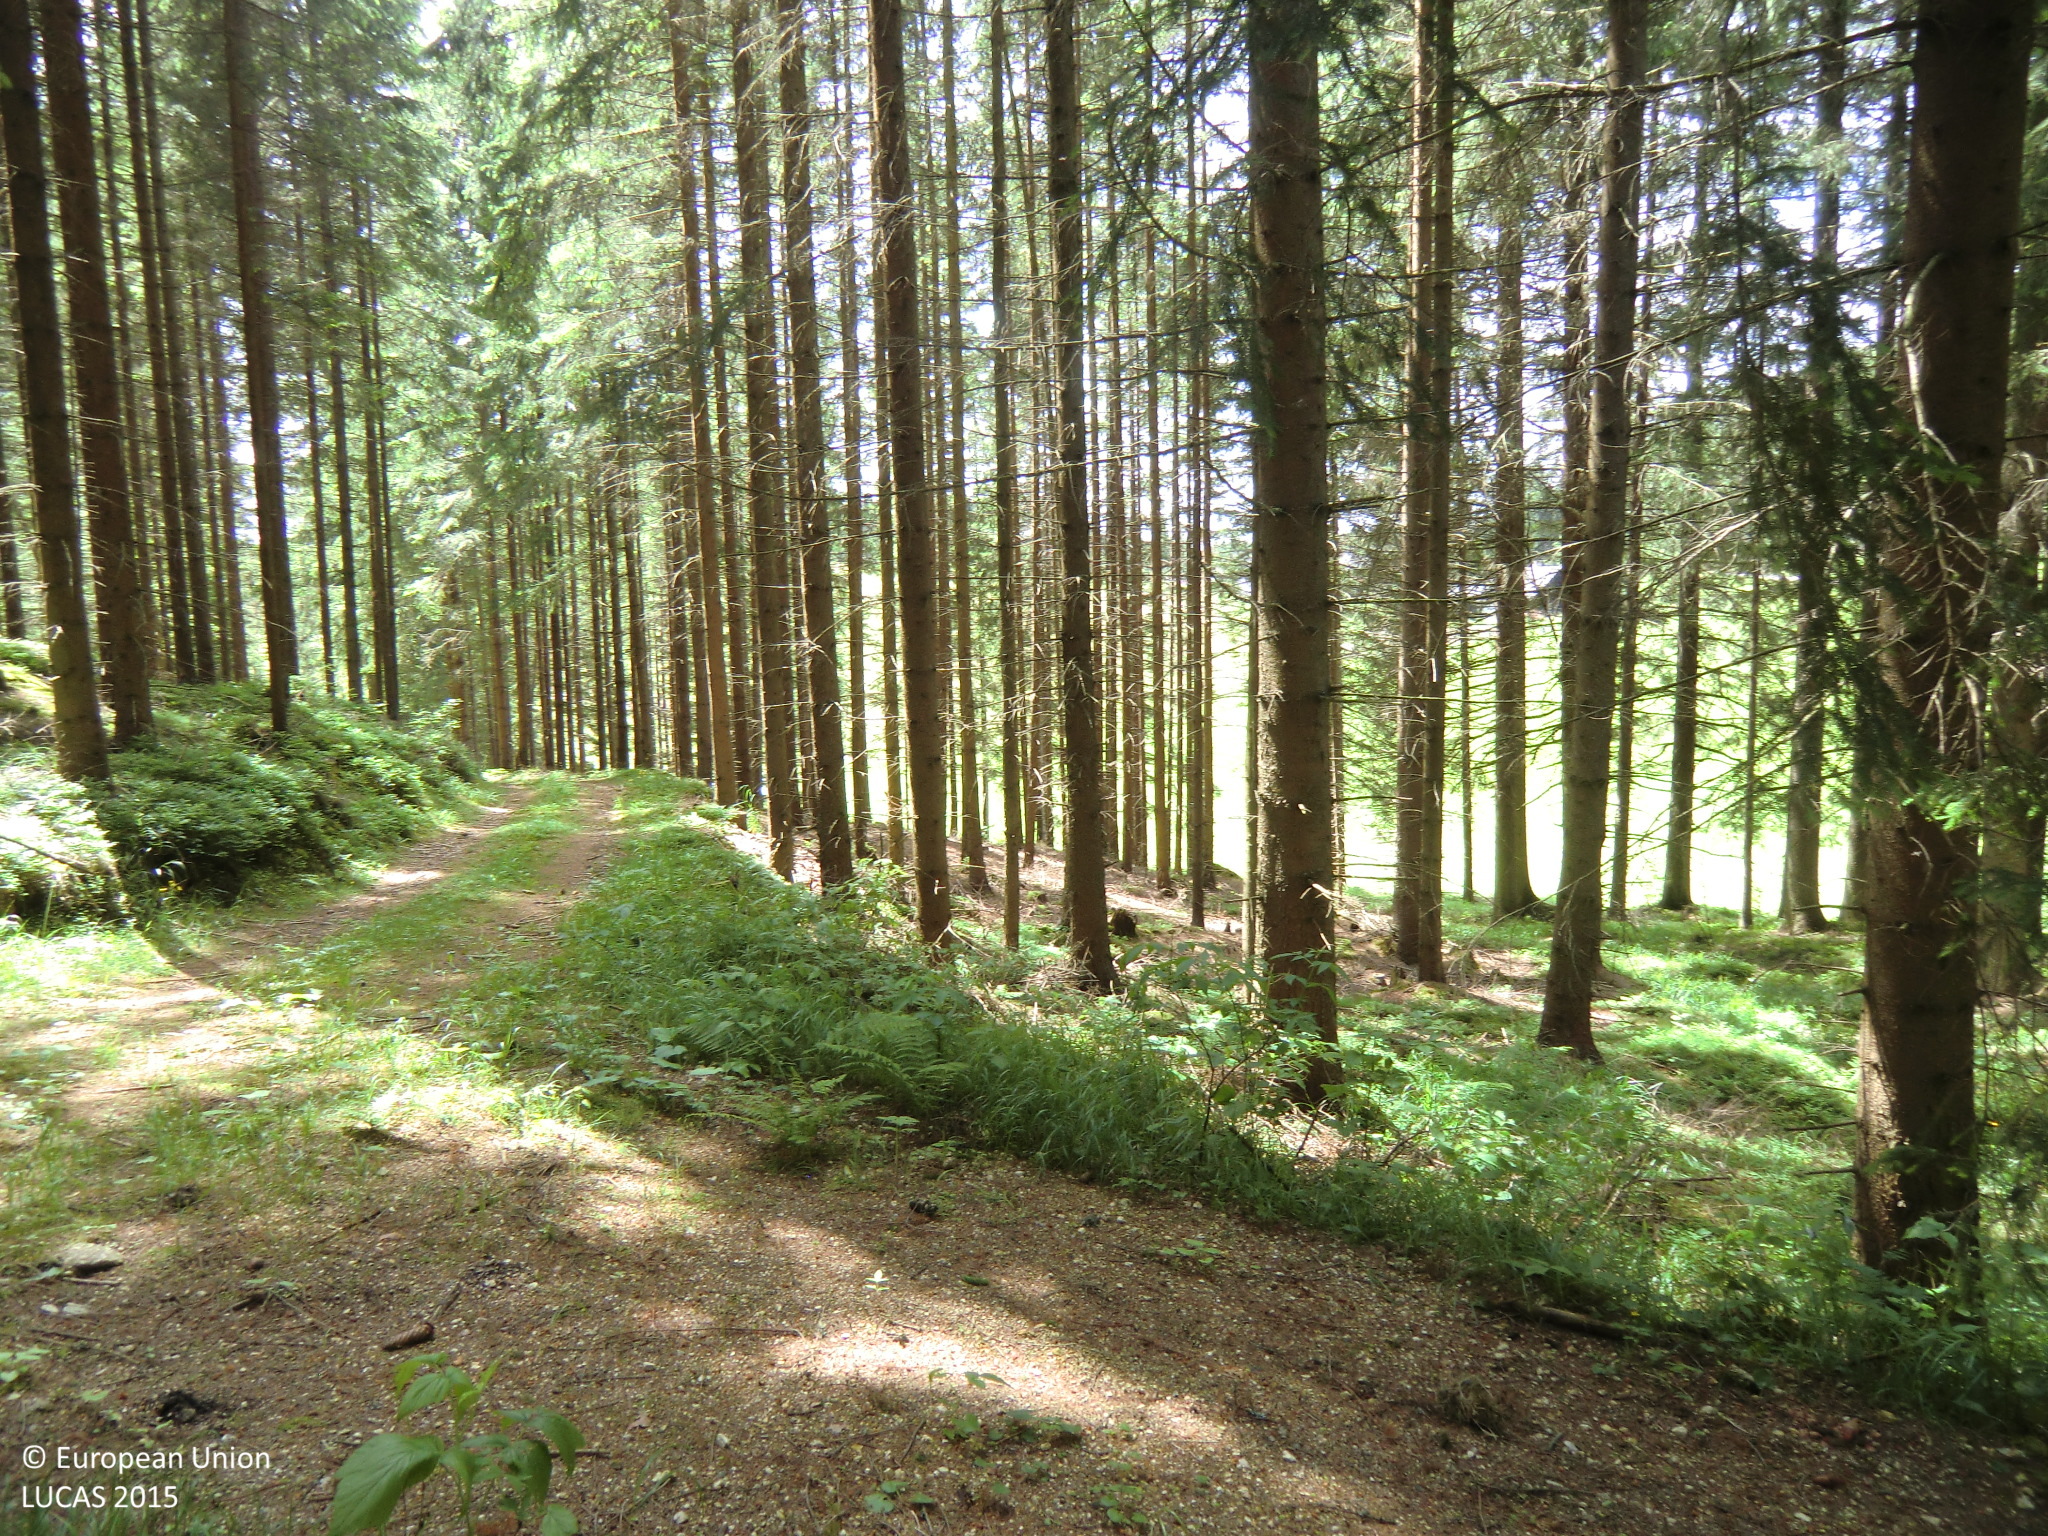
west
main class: Woodland
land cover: Spruce dominated coniferous woodland
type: hemiboreal forest and nemoral coniferous forest and mixed broadleaved-coniferous forest
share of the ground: > 75 %
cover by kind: coniferous forest trees 80 %, shrubs 10 %, herbaceous plants 10 %
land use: Forestry
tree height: > 5 m
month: June
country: AT
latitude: 48.5309
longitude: 14.8629
